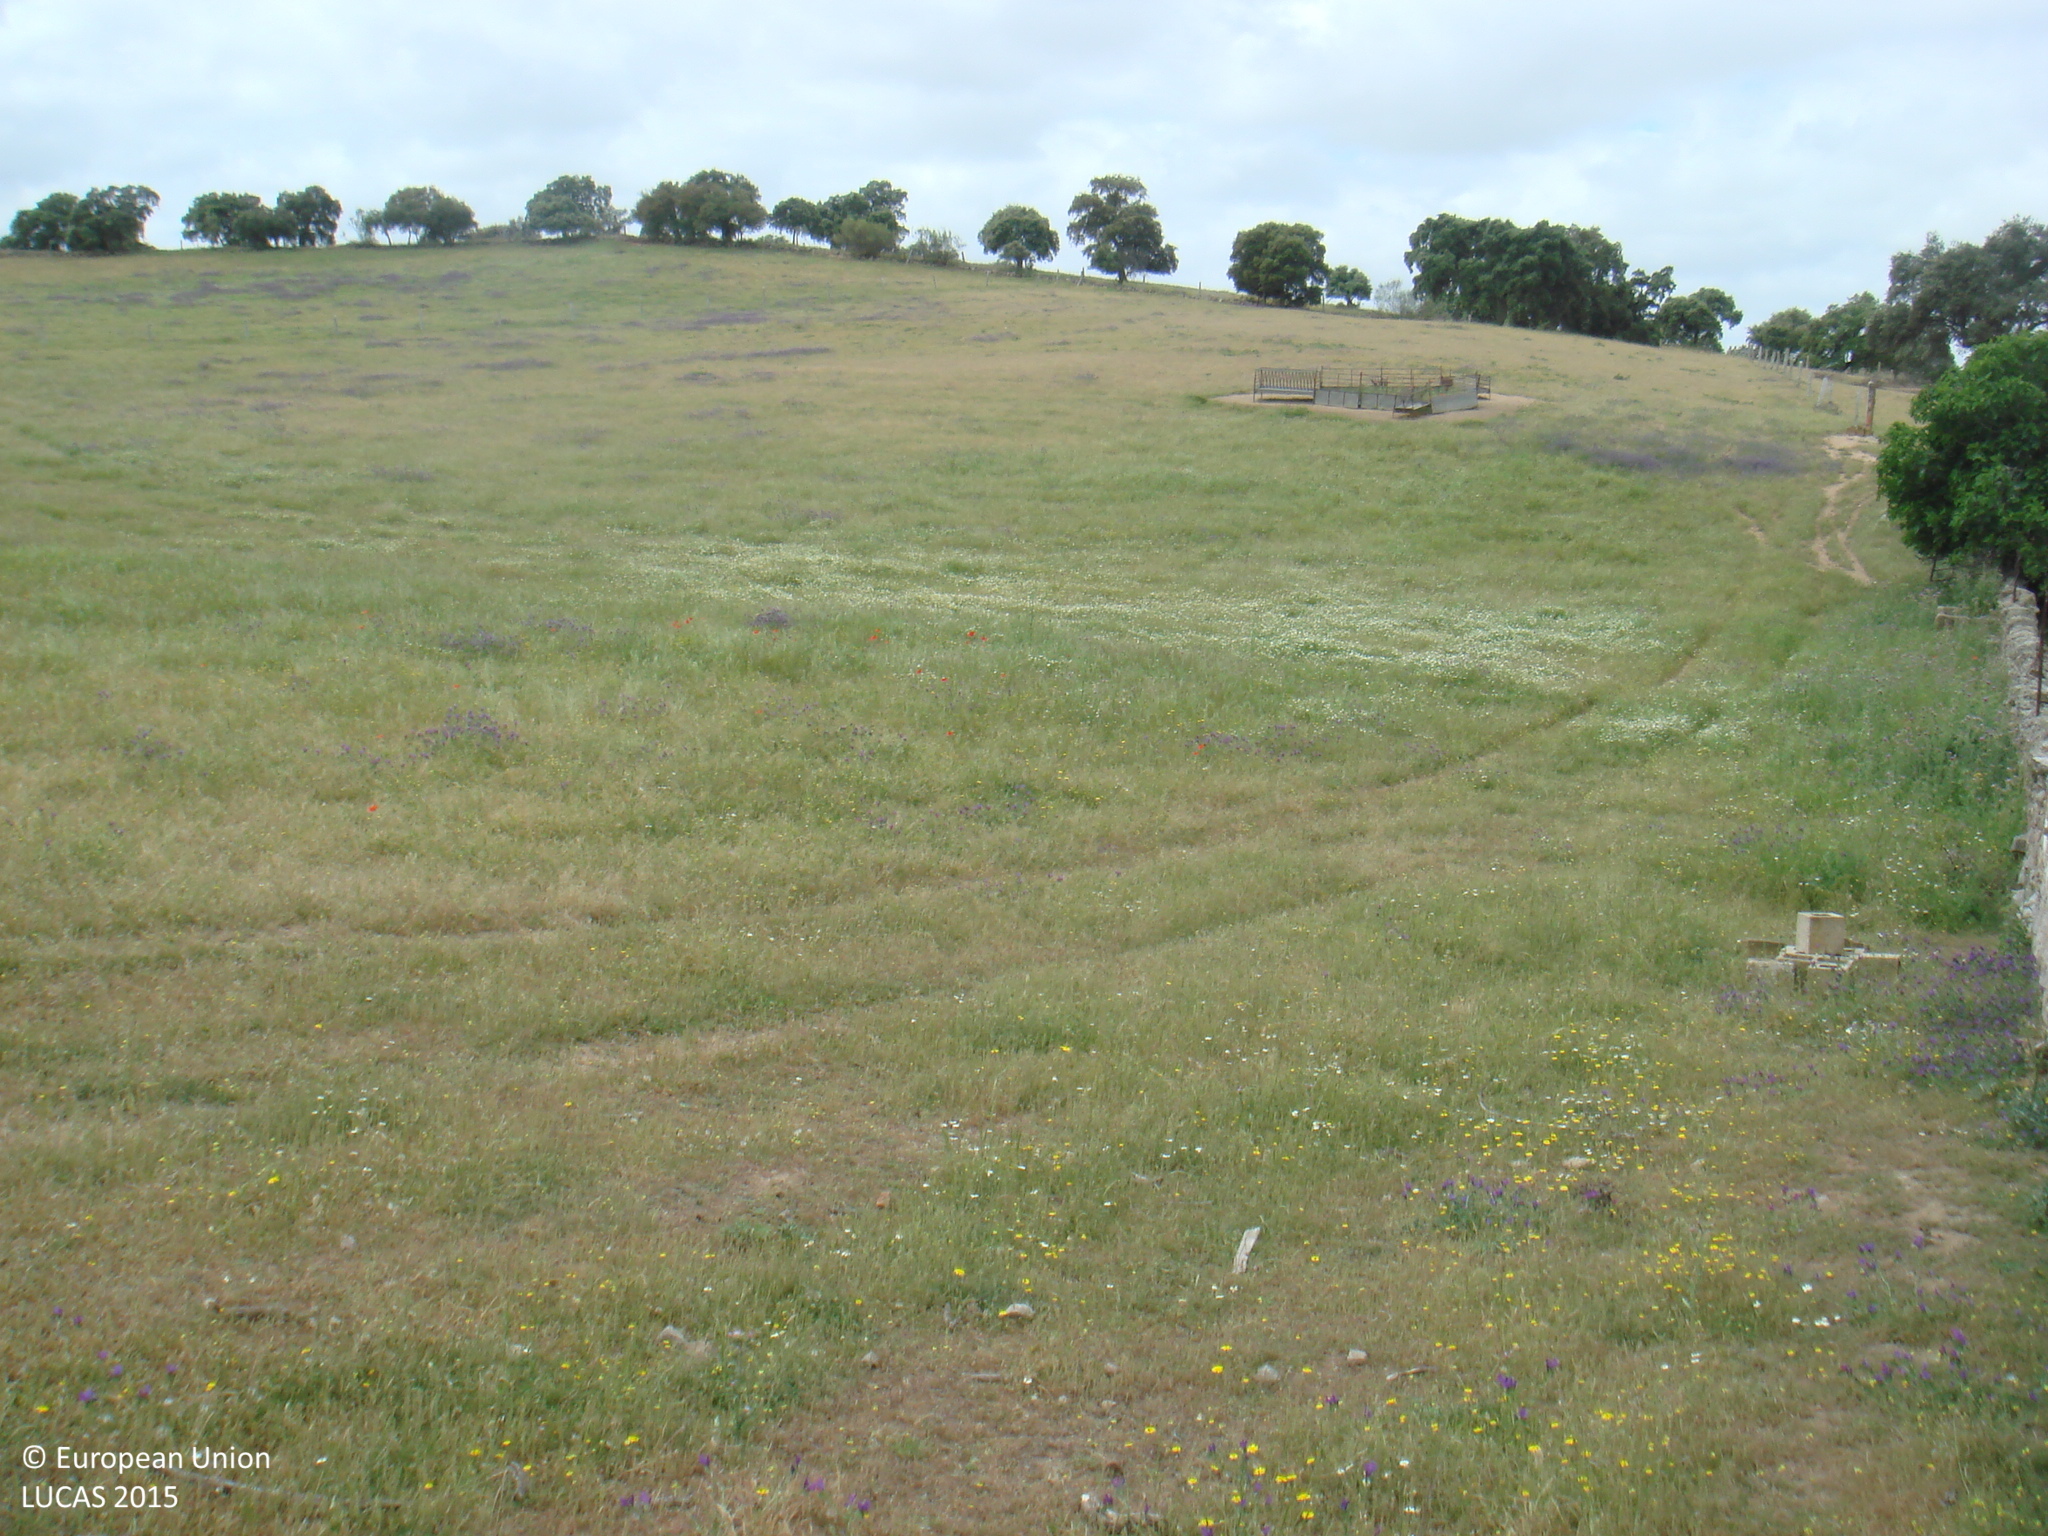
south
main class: Grassland
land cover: Grassland without tree/shrub cover
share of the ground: > 75 %
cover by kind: herbaceous plants 100 %
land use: Agriculture (excluding fallow land and kitchen gardens)
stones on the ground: < 10 %
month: May
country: ES
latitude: 38.4481
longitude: -4.7468
